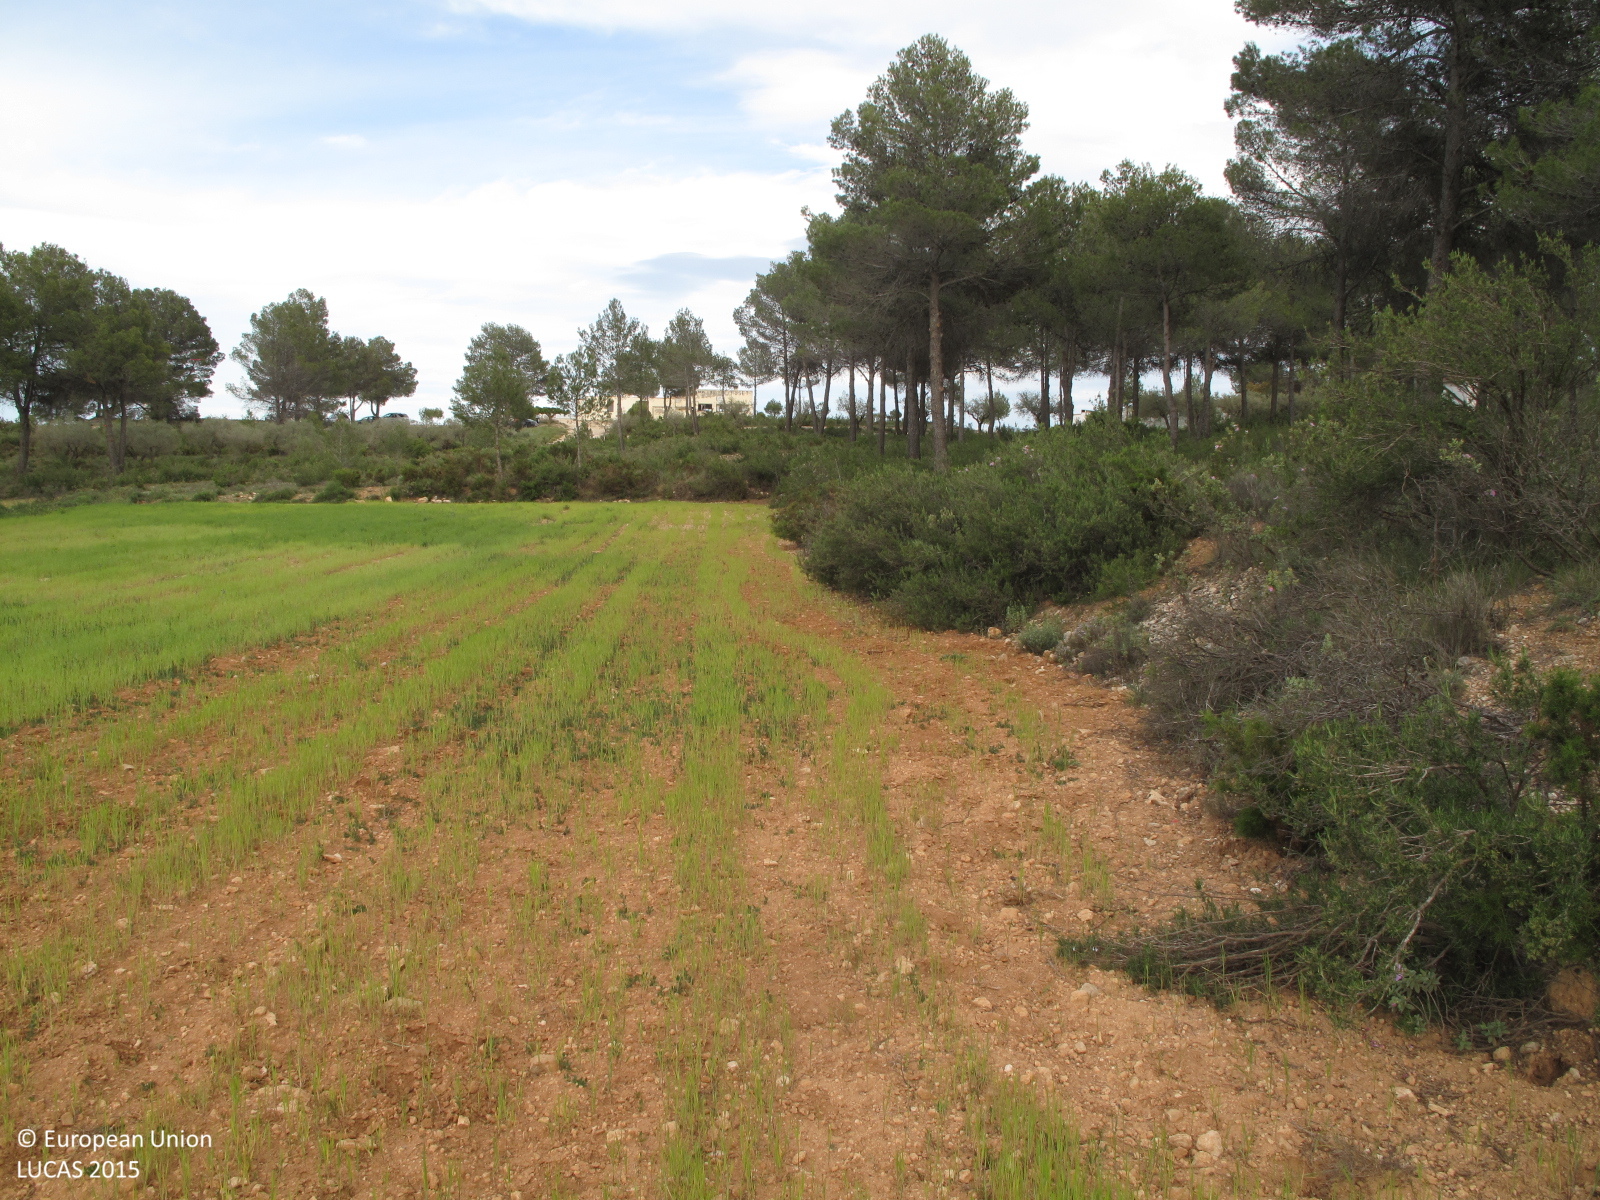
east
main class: Cropland
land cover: Common wheat
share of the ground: 50 - 75 %
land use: Agriculture (excluding fallow land and kitchen gardens)
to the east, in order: Common wheat; Shrubland with sparse tree cover; Pine dominated coniferous woodland; Groves; Tracks; Groves; Pine dominated coniferous woodland; Fences; Other bare soil; Groves; Other bare soil; Grassland without tree/shrub cover
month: May
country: ES
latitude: 38.7853
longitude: -0.7089
